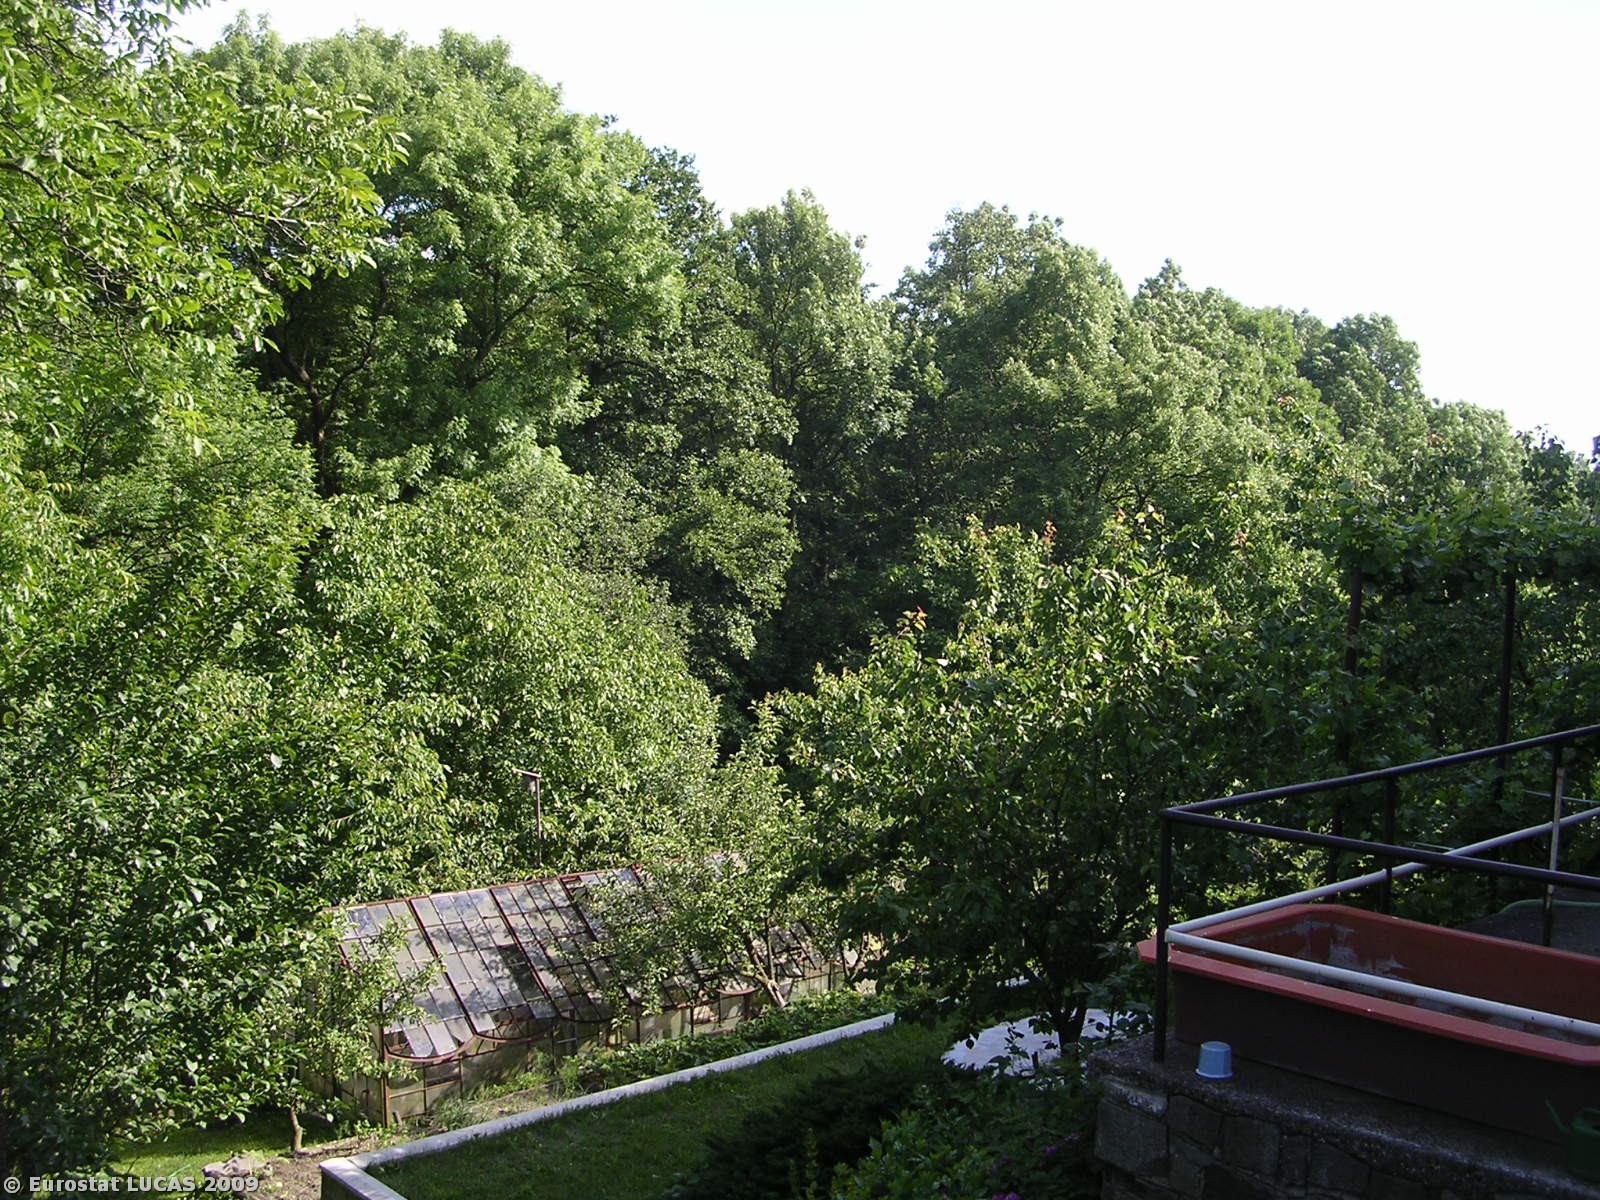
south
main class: Grassland
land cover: Grassland with sparse tree/shrub cover
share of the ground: > 75 %
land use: Residential
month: June
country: CZ
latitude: 50.5552
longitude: 14.2499
